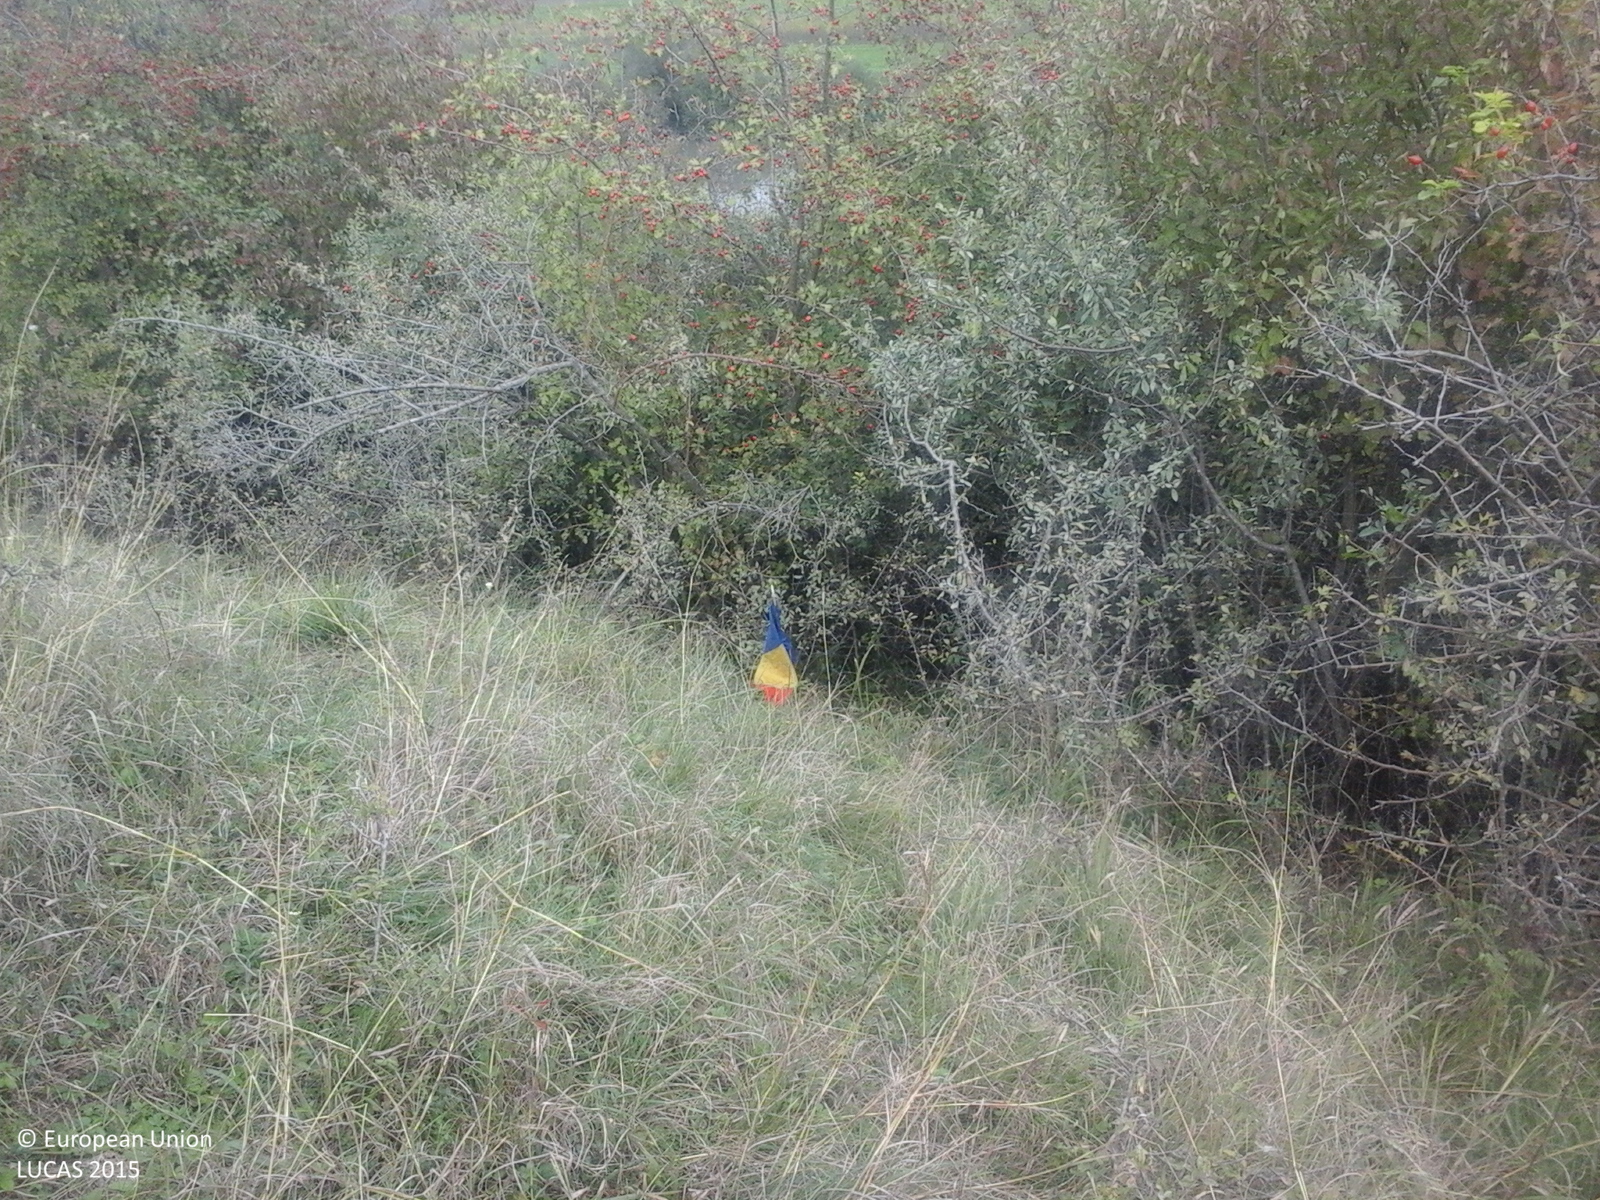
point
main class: Shrubland
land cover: Shrubland without tree cover
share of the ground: > 75 %
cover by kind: shrubs 100 %
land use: Semi-natural and natural areas not in use
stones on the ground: < 10 %
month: October
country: RO
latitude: 46.4422
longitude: 24.0440
